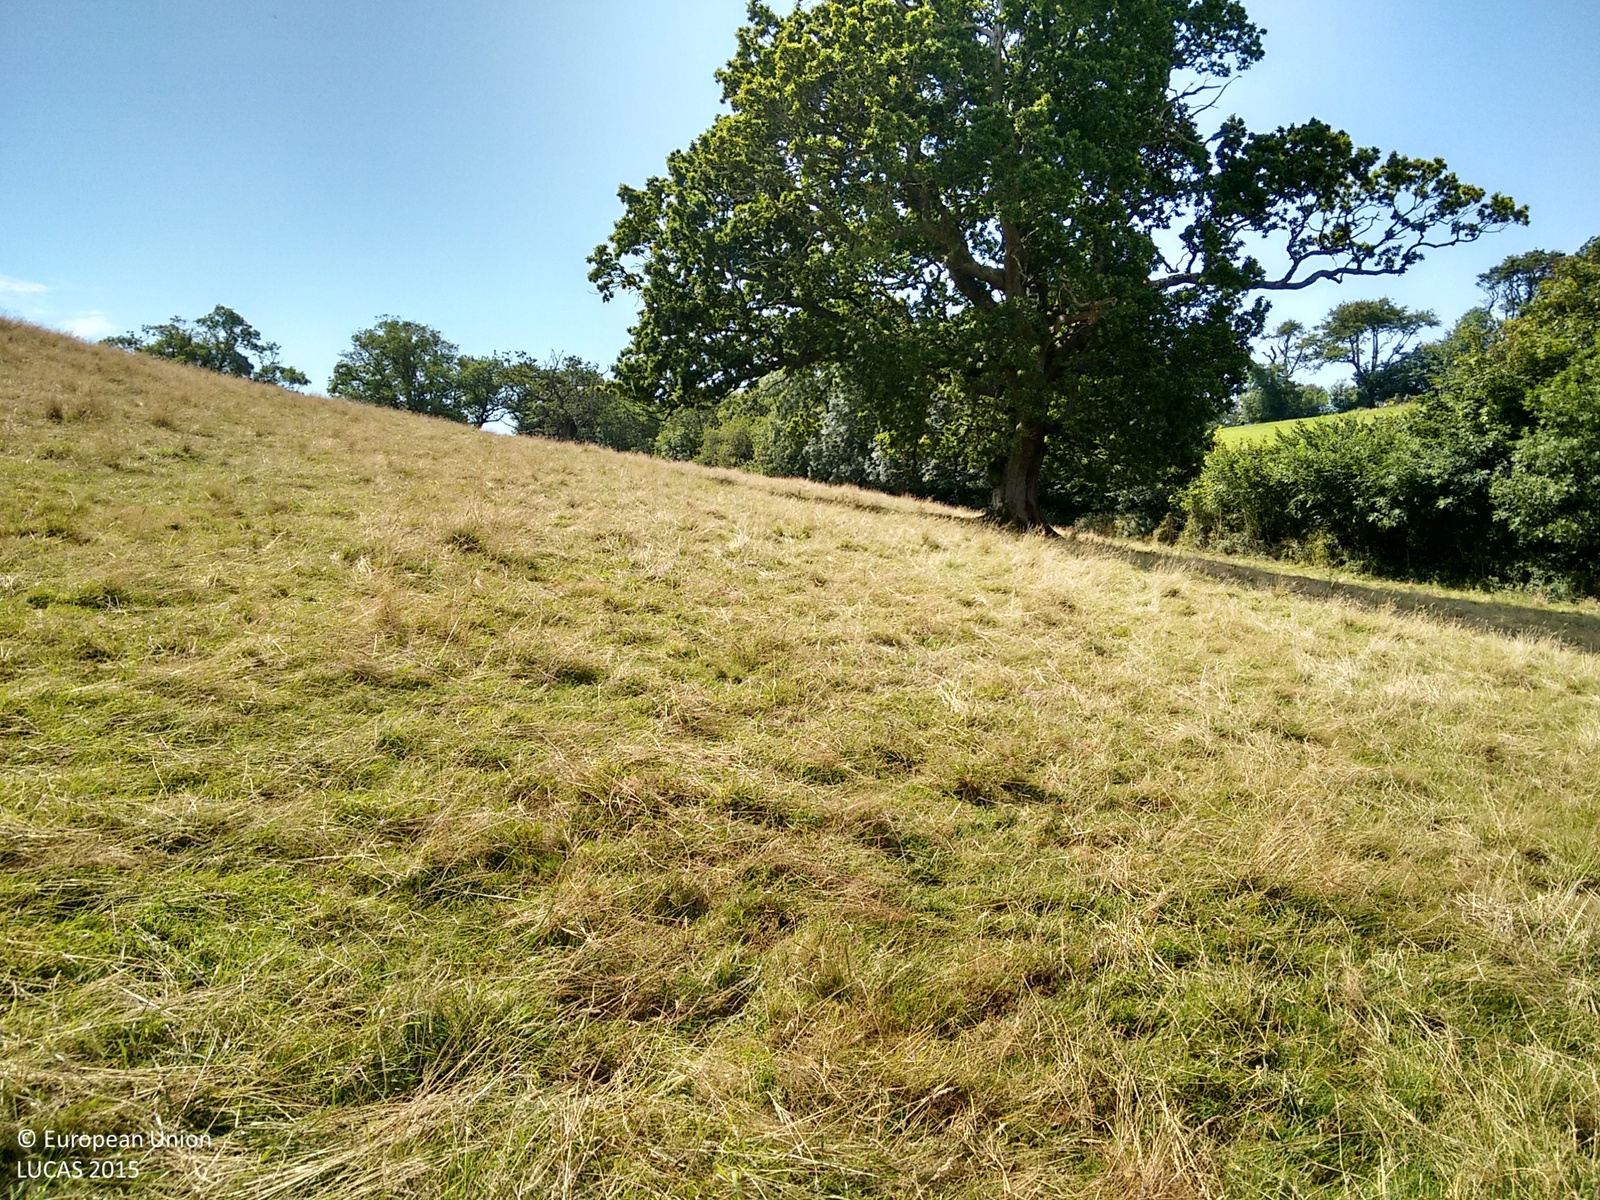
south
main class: Grassland
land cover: Grassland with sparse tree/shrub cover
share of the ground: > 75 %
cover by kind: herbaceous plants 95 %, broadleaved forest trees 5 %
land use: Agriculture (excluding fallow land and kitchen gardens)
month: August
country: GB
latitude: 51.7878
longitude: -4.3826
